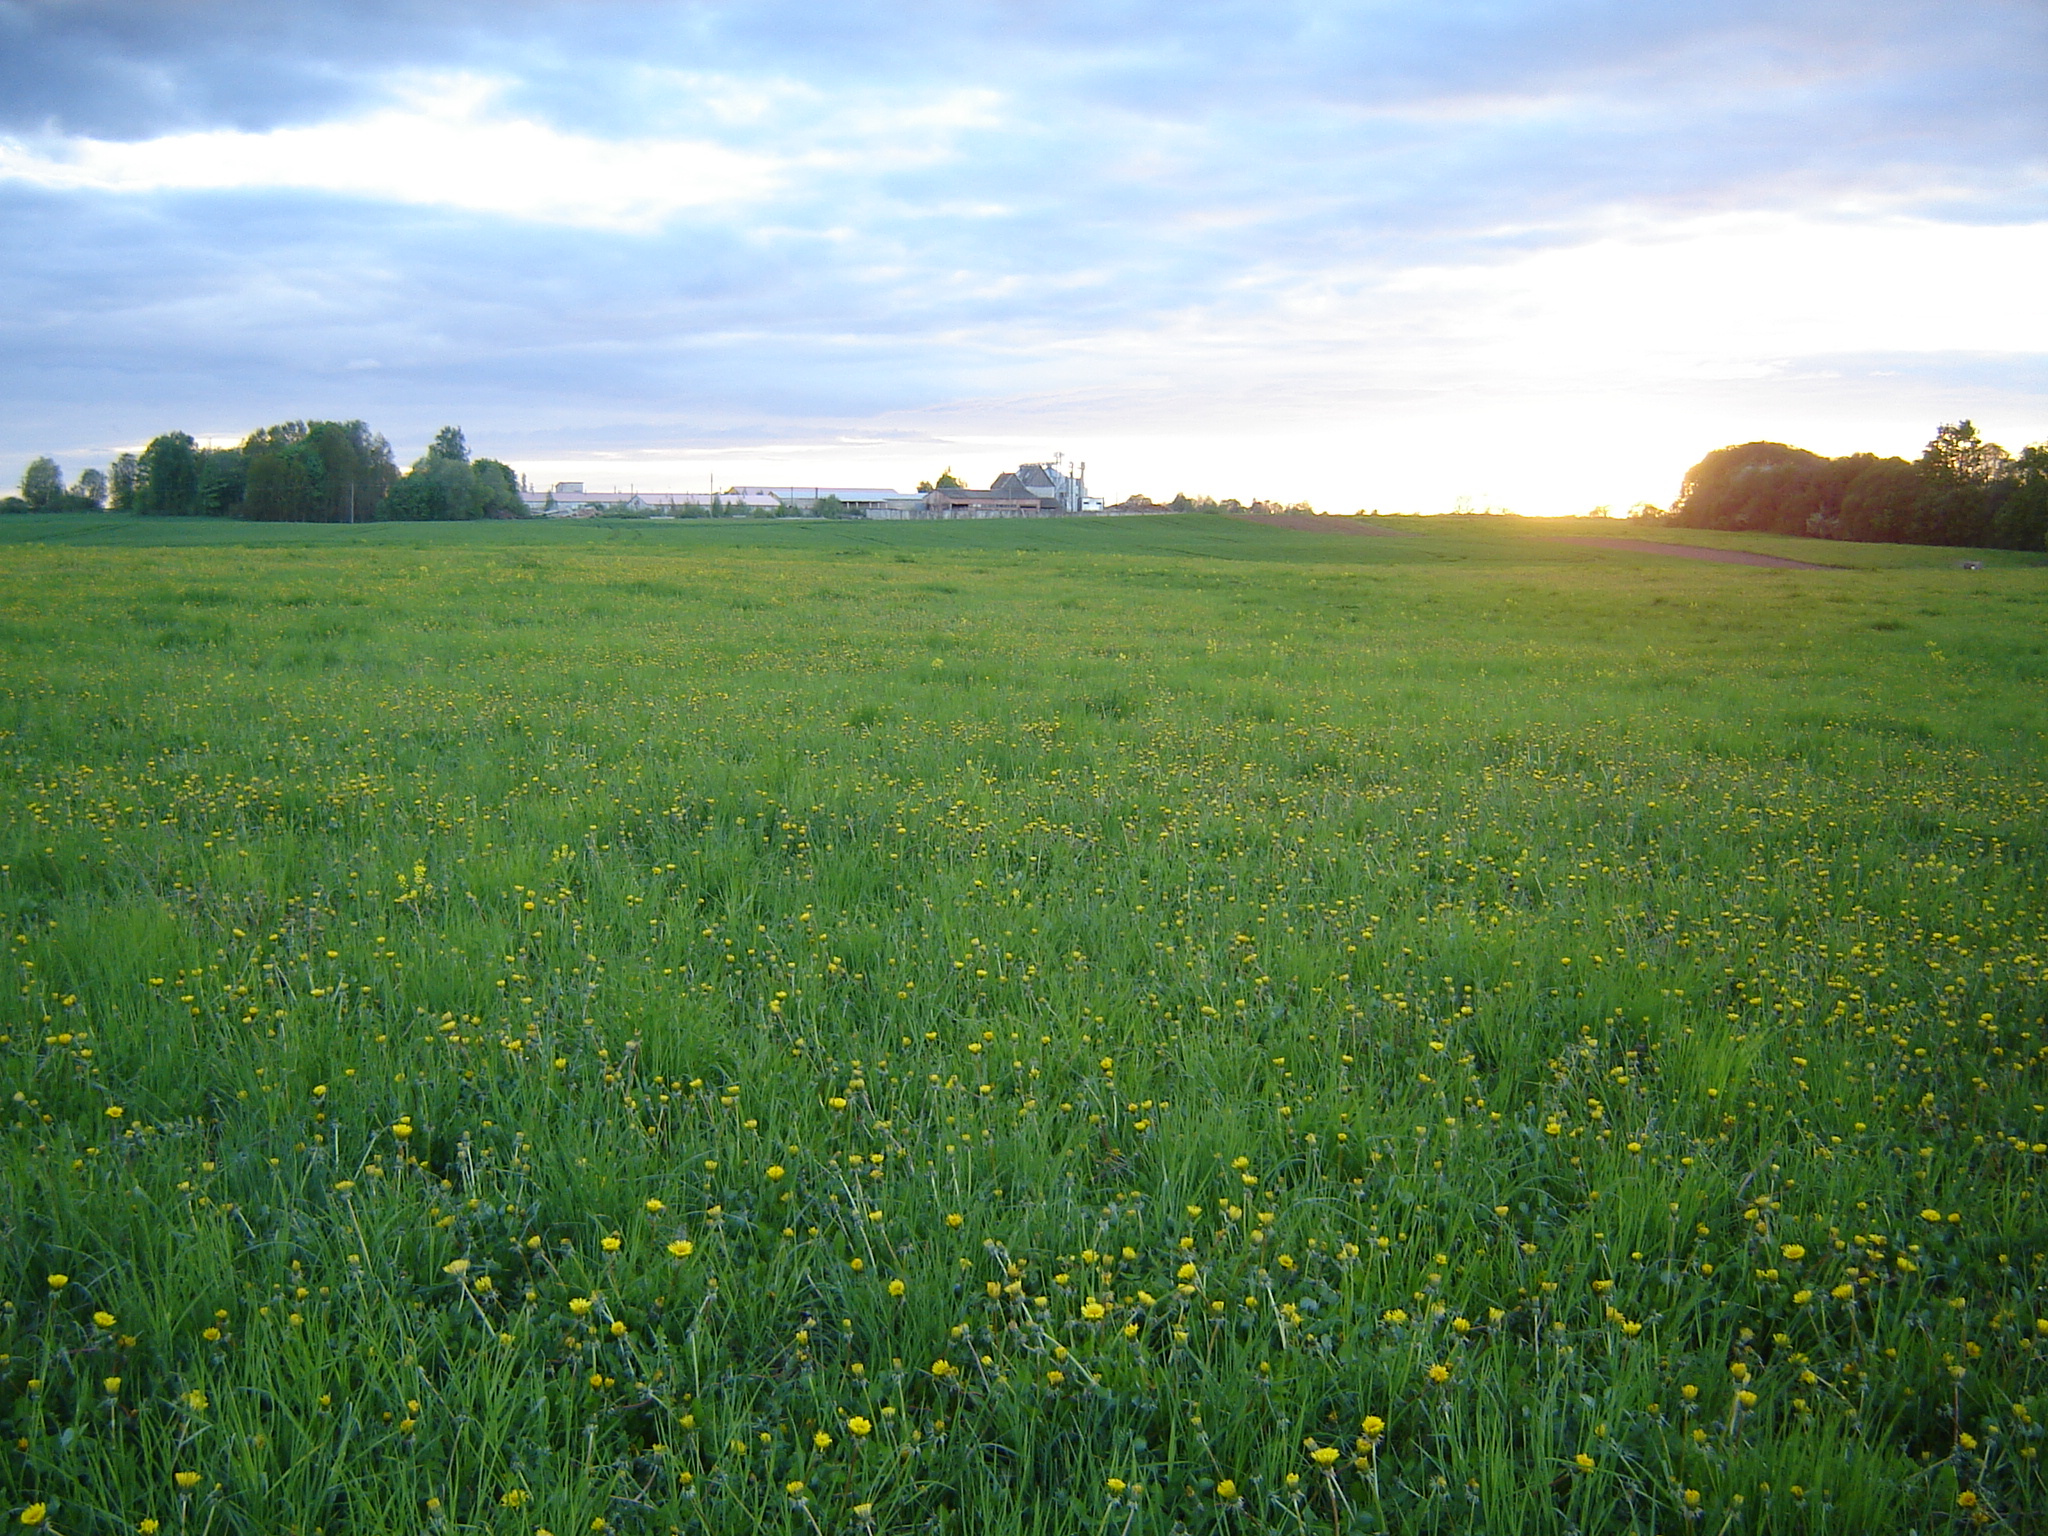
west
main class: Grassland
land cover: Grassland without tree/shrub cover
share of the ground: > 75 %
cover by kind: herbaceous plants 100 %
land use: Agriculture (excluding fallow land and kitchen gardens)
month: May
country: LT
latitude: 56.0521
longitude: 25.2901
